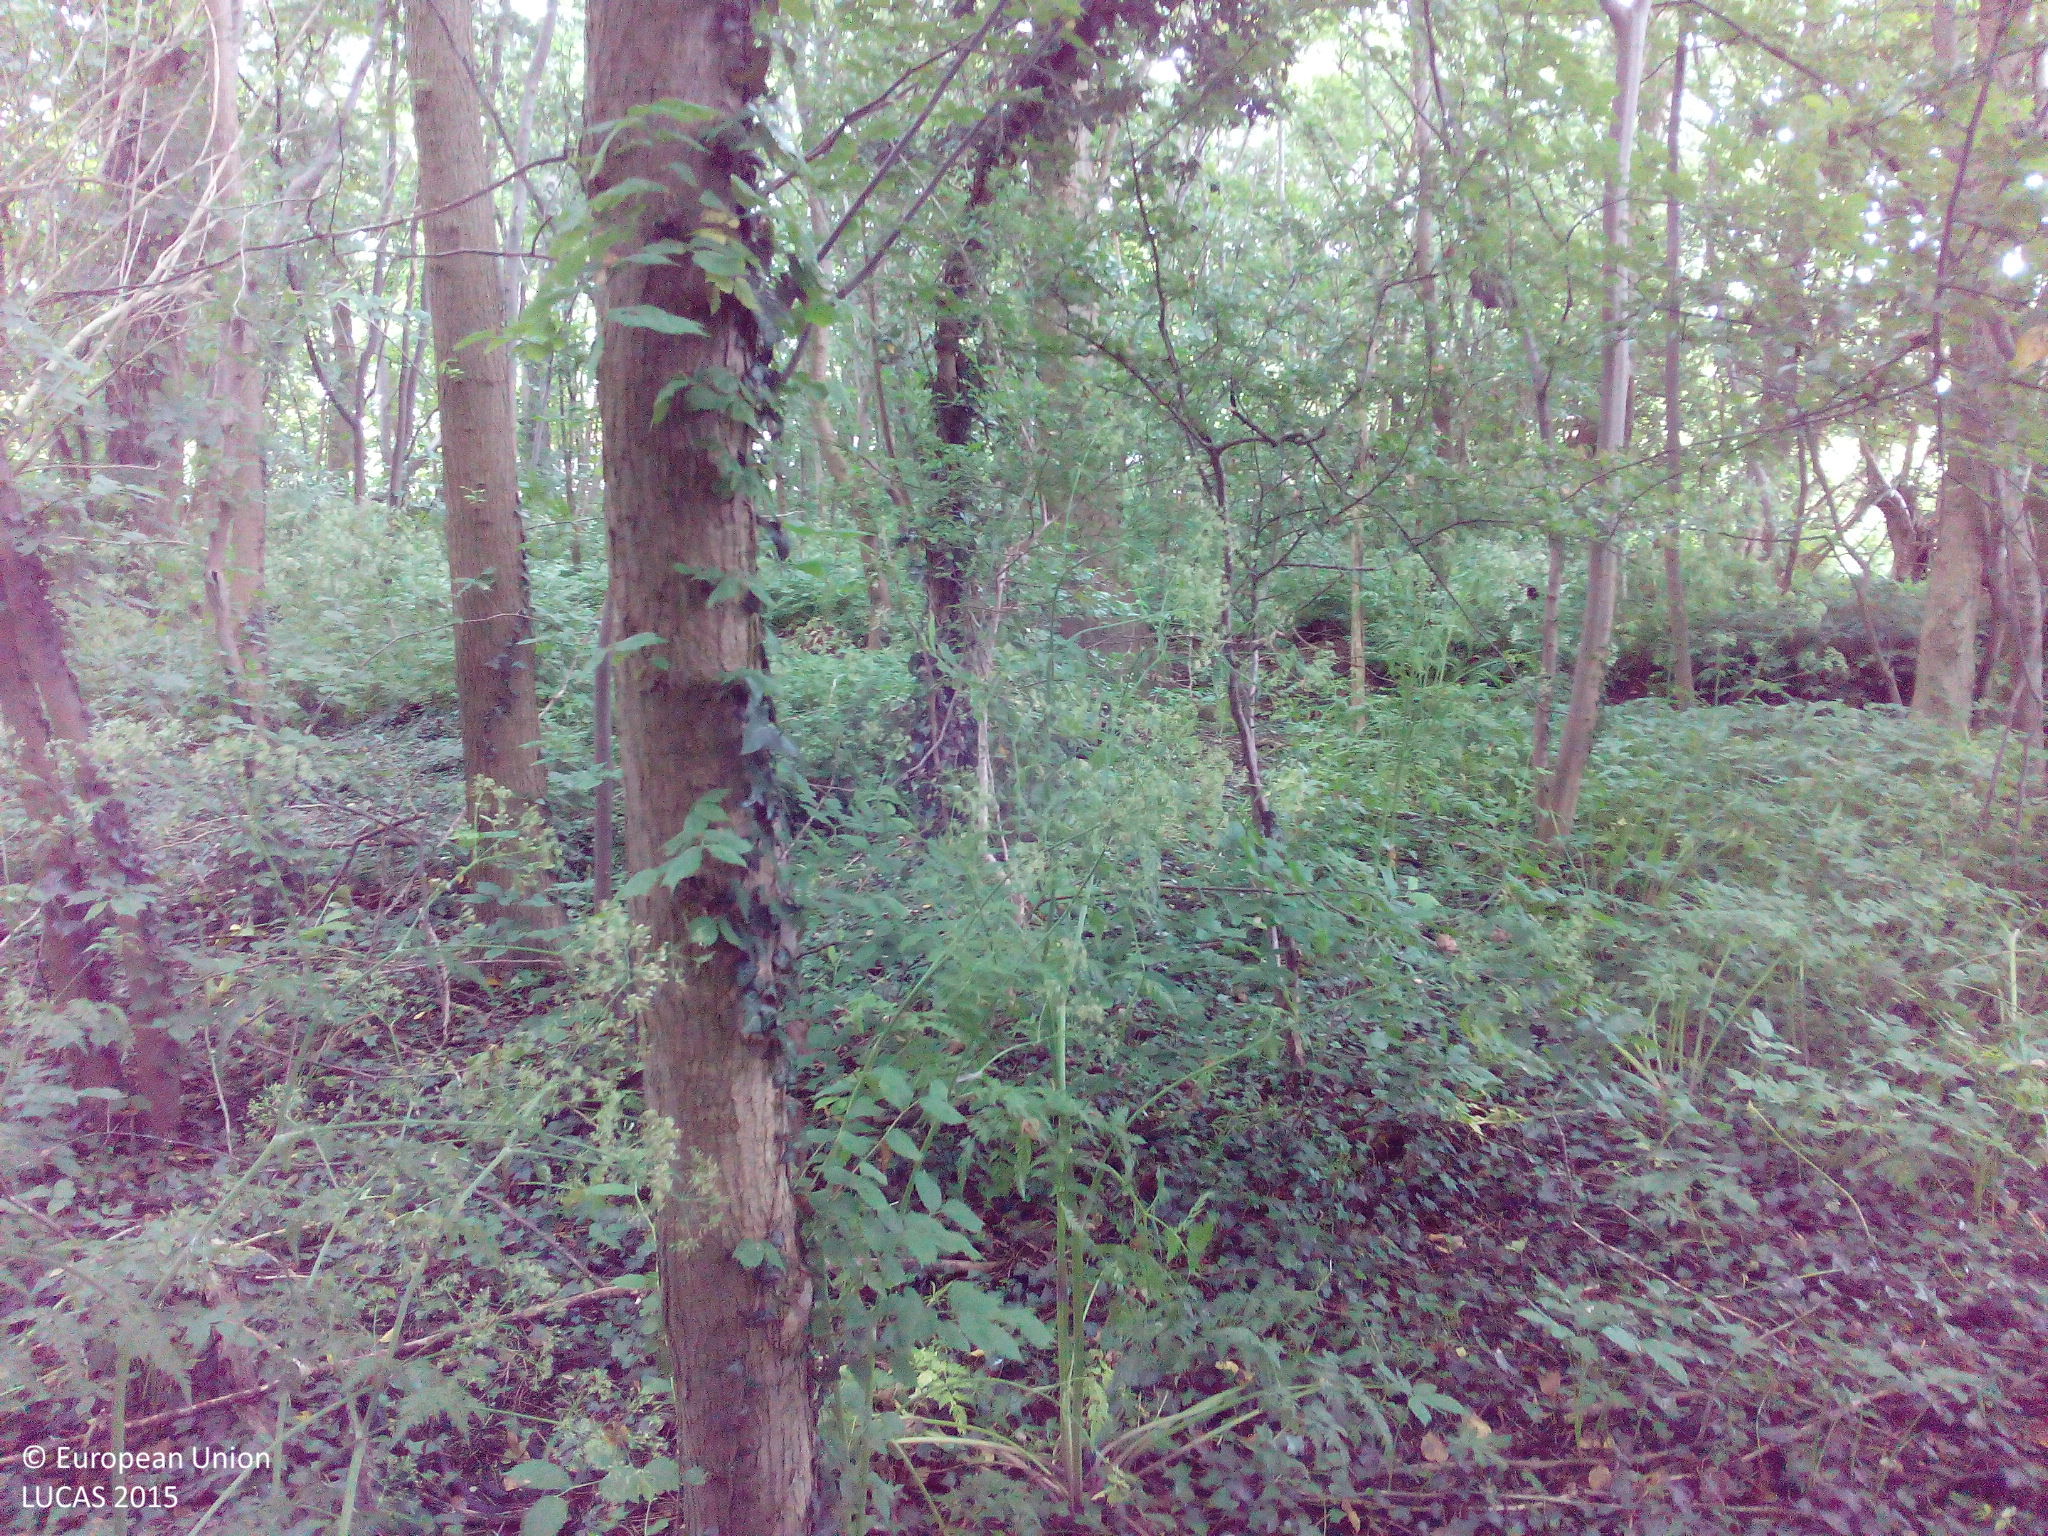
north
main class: Woodland
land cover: Broadleaved woodland
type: beech forest
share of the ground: > 75 %
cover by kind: broadleaved forest trees 100 %
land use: Residential
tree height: > 5 m
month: June
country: DK
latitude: 54.9452
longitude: 10.7644
